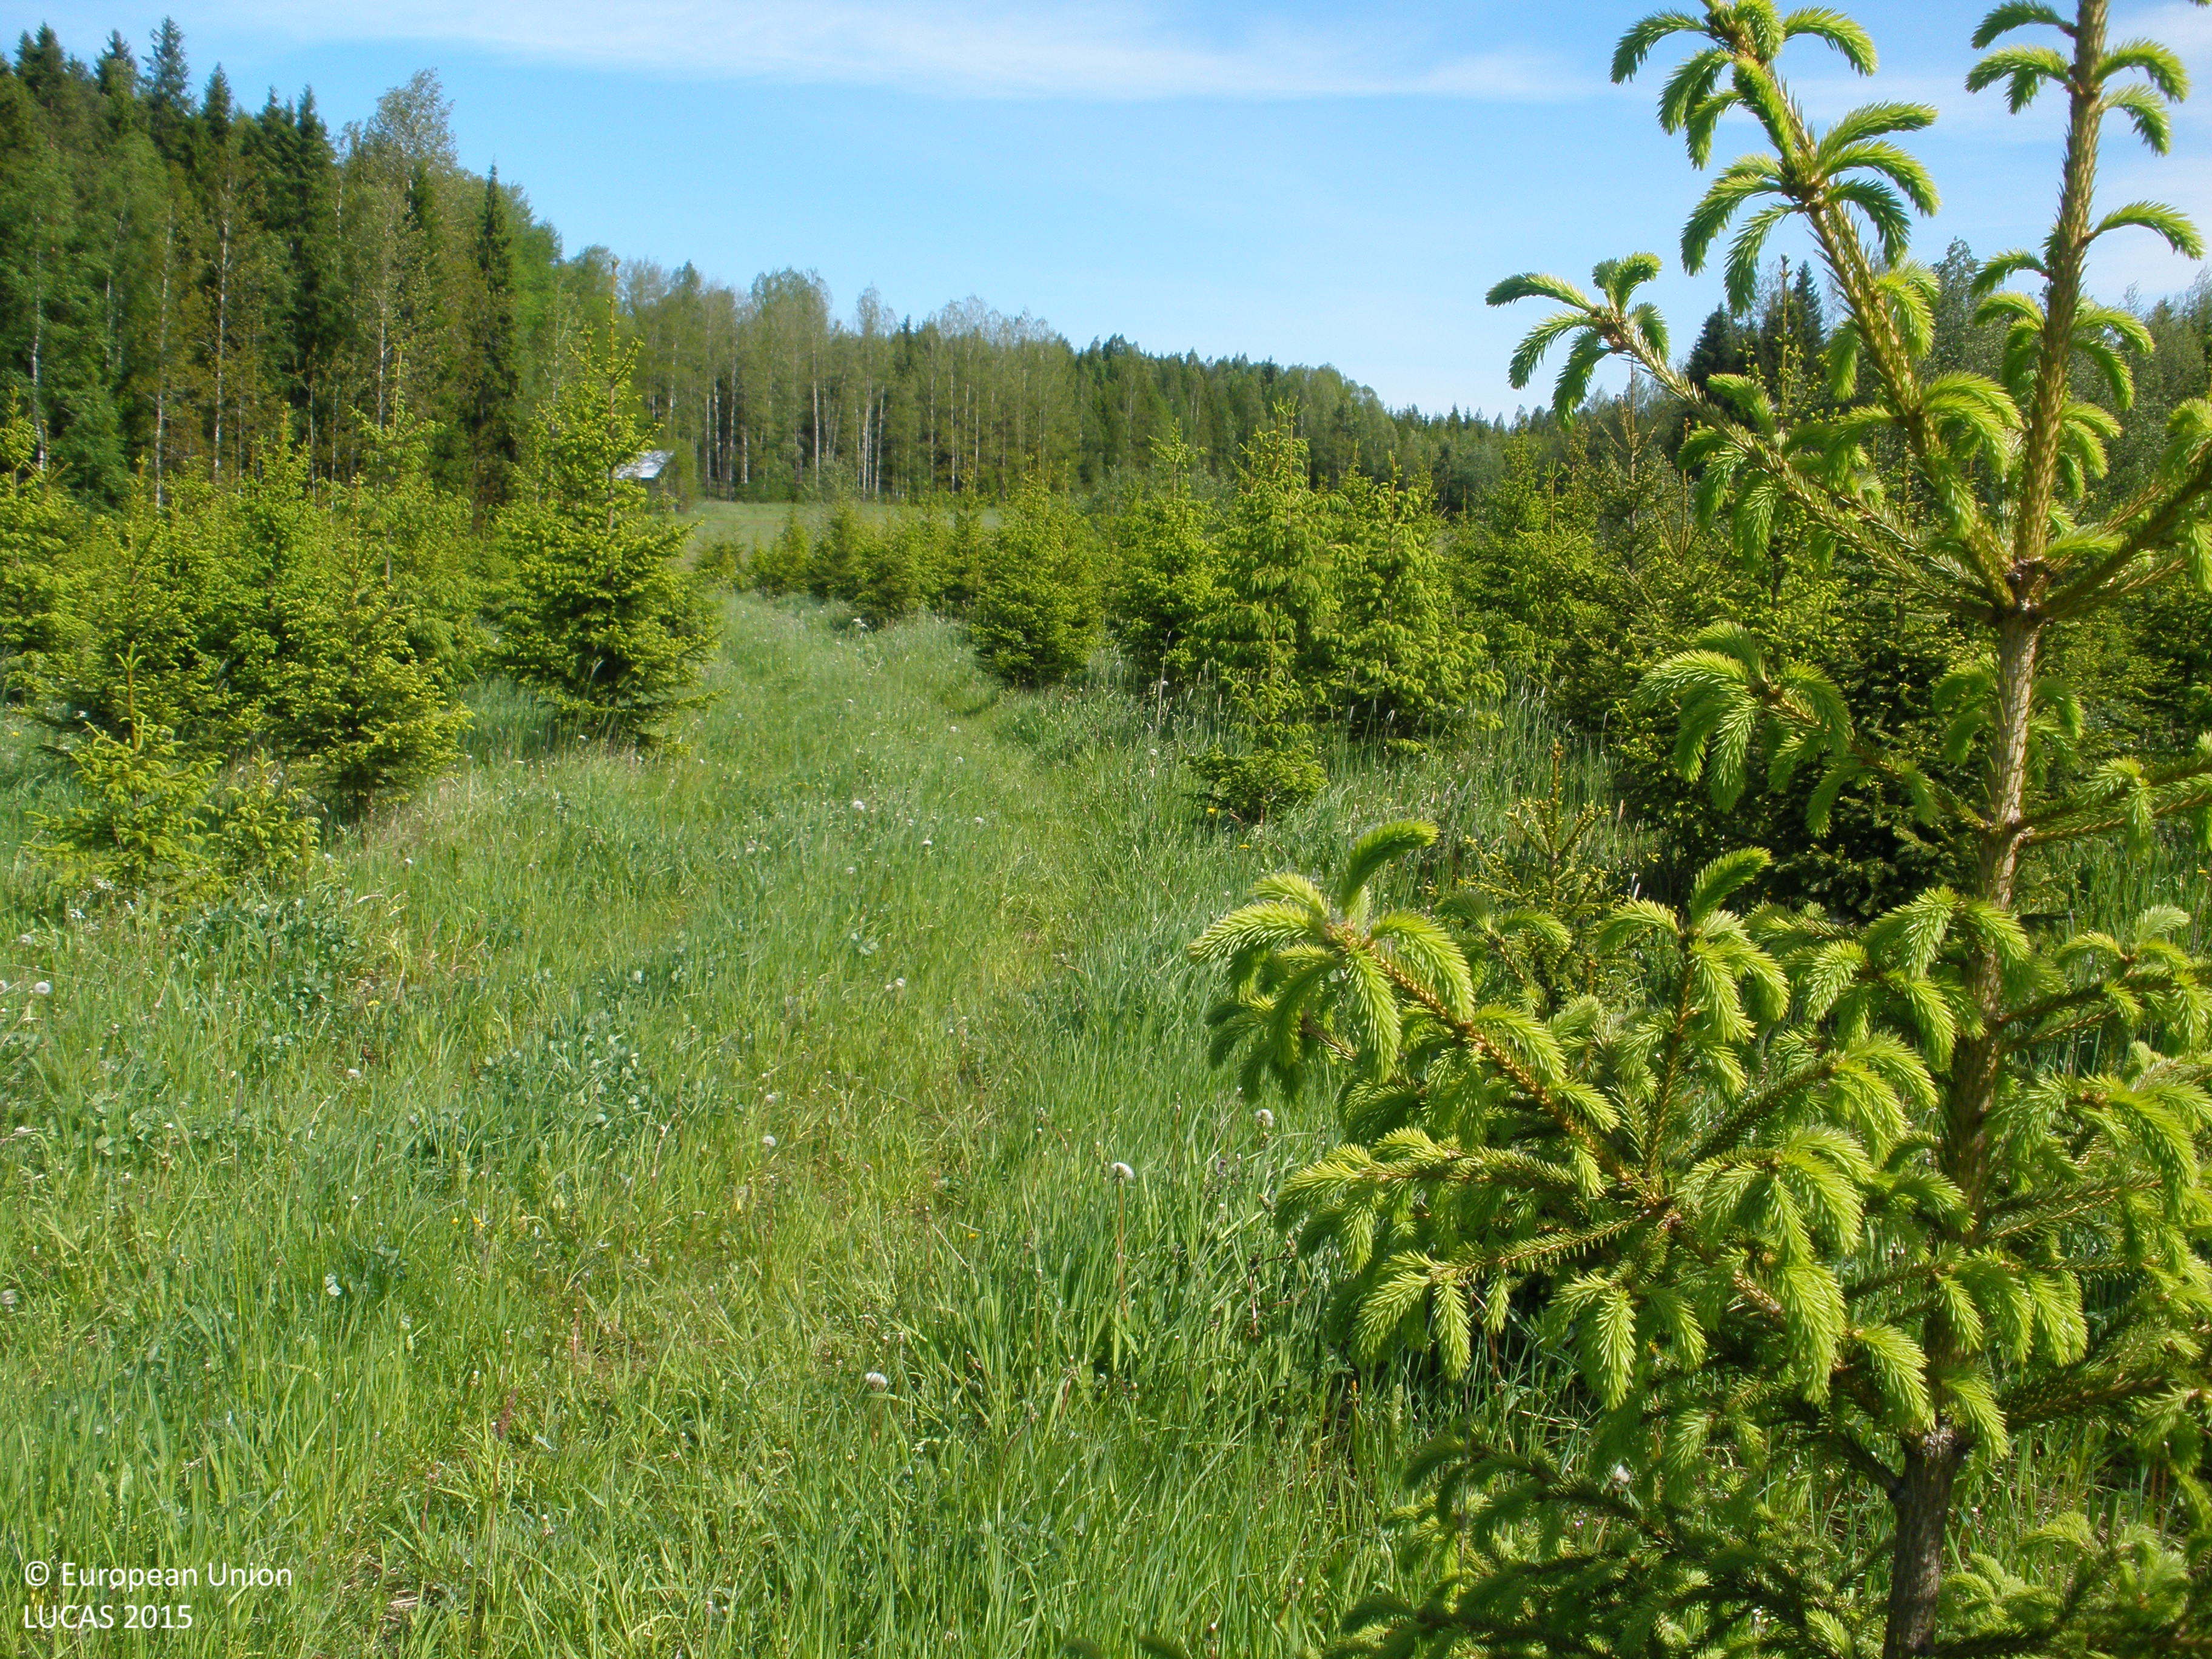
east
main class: Woodland
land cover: Spruce dominated coniferous woodland
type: boreal forest
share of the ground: 25 - 50 %
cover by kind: herbaceous plants 65 %, coniferous forest trees 35 %
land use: Forestry
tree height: < 5 m
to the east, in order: Spruce dominated coniferous woodland; Tracks; Spruce dominated mixed woodland; Grassland with sparse tree/shrub cover; Ditches and canals; Temporary grasslands; Ditches and canals; Temporary grasslands; Spruce dominated mixed woodland
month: June
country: FI
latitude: 60.7193
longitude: 23.4836
